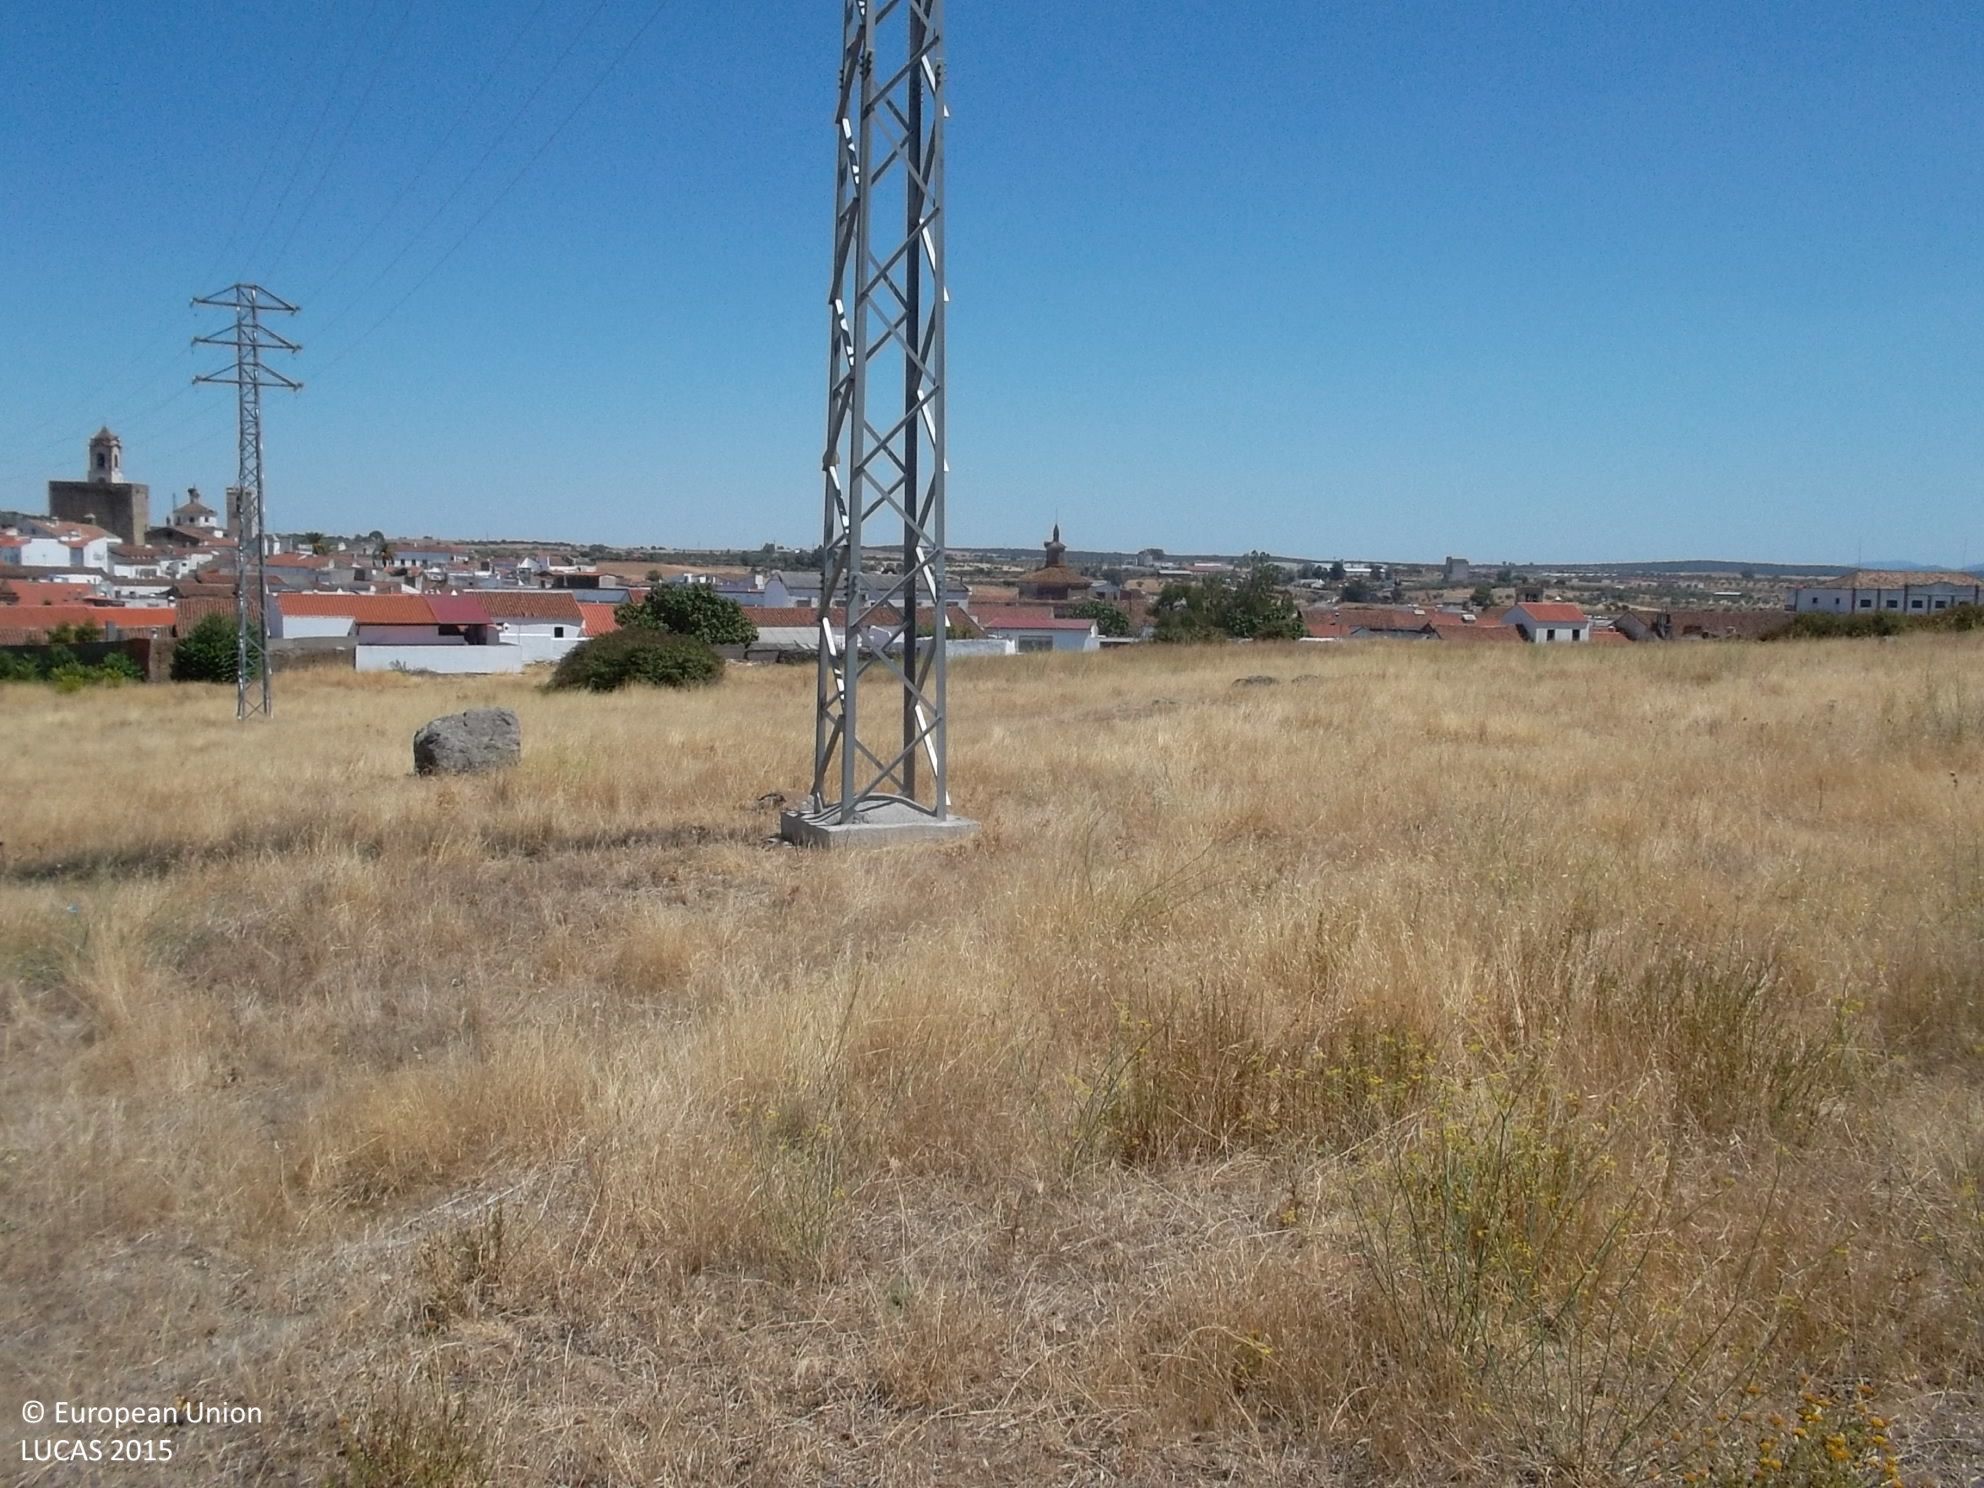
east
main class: Grassland
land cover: Spontaneously vegetated surfaces
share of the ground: > 75 %
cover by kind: herbaceous plants 100 %
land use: Fallow land
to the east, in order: Spontaneously vegetated surfaces; Electric lines; Spontaneously vegetated surfaces; Tracks; Spontaneously vegetated surfaces; Dry stone walls; Spontaneously vegetated surfaces; Tracks; Spontaneously vegetated surfaces; Dry stone walls; Artificial constructions in urban areas
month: August
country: ES
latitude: 38.1681
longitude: -6.6579
